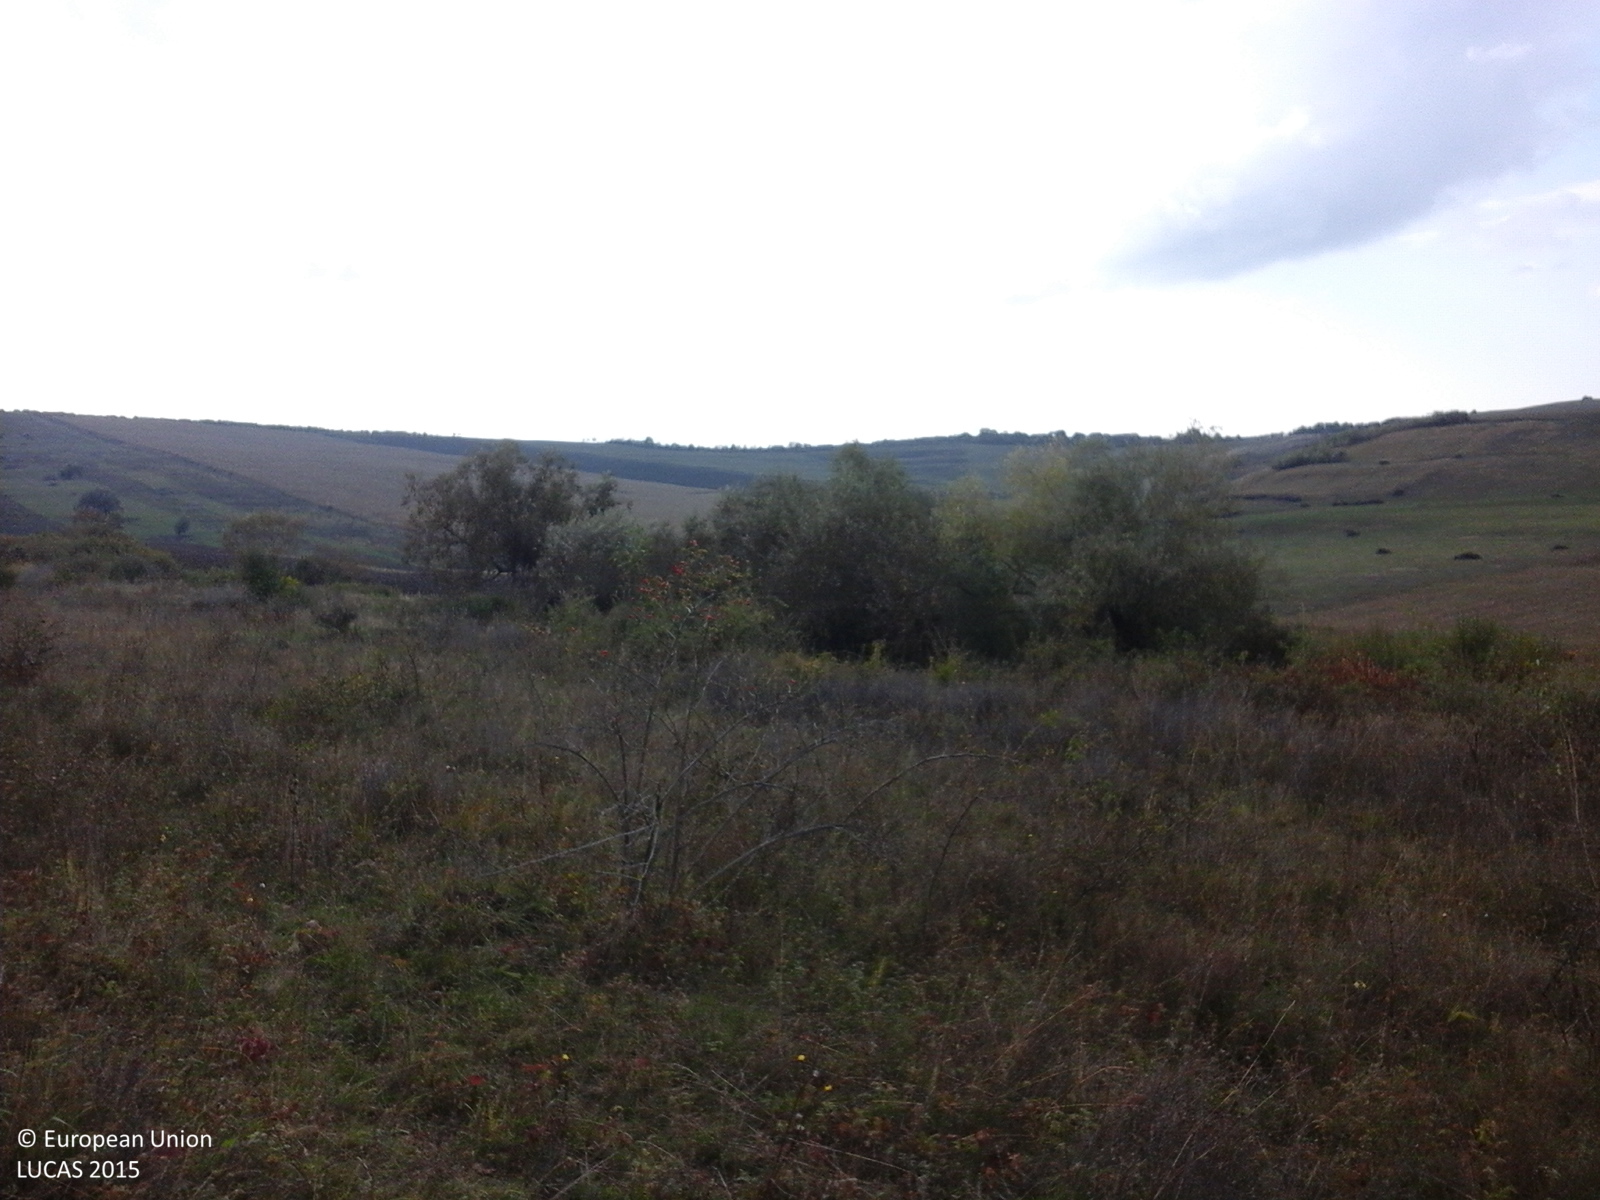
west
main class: Grassland
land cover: Grassland with sparse tree/shrub cover
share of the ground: > 75 %
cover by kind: herbaceous plants 85 %, shrubs 10 %, broadleaved forest trees 5 %
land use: Fallow land
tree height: < 5 m
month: October
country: RO
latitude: 46.3834
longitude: 24.3466
